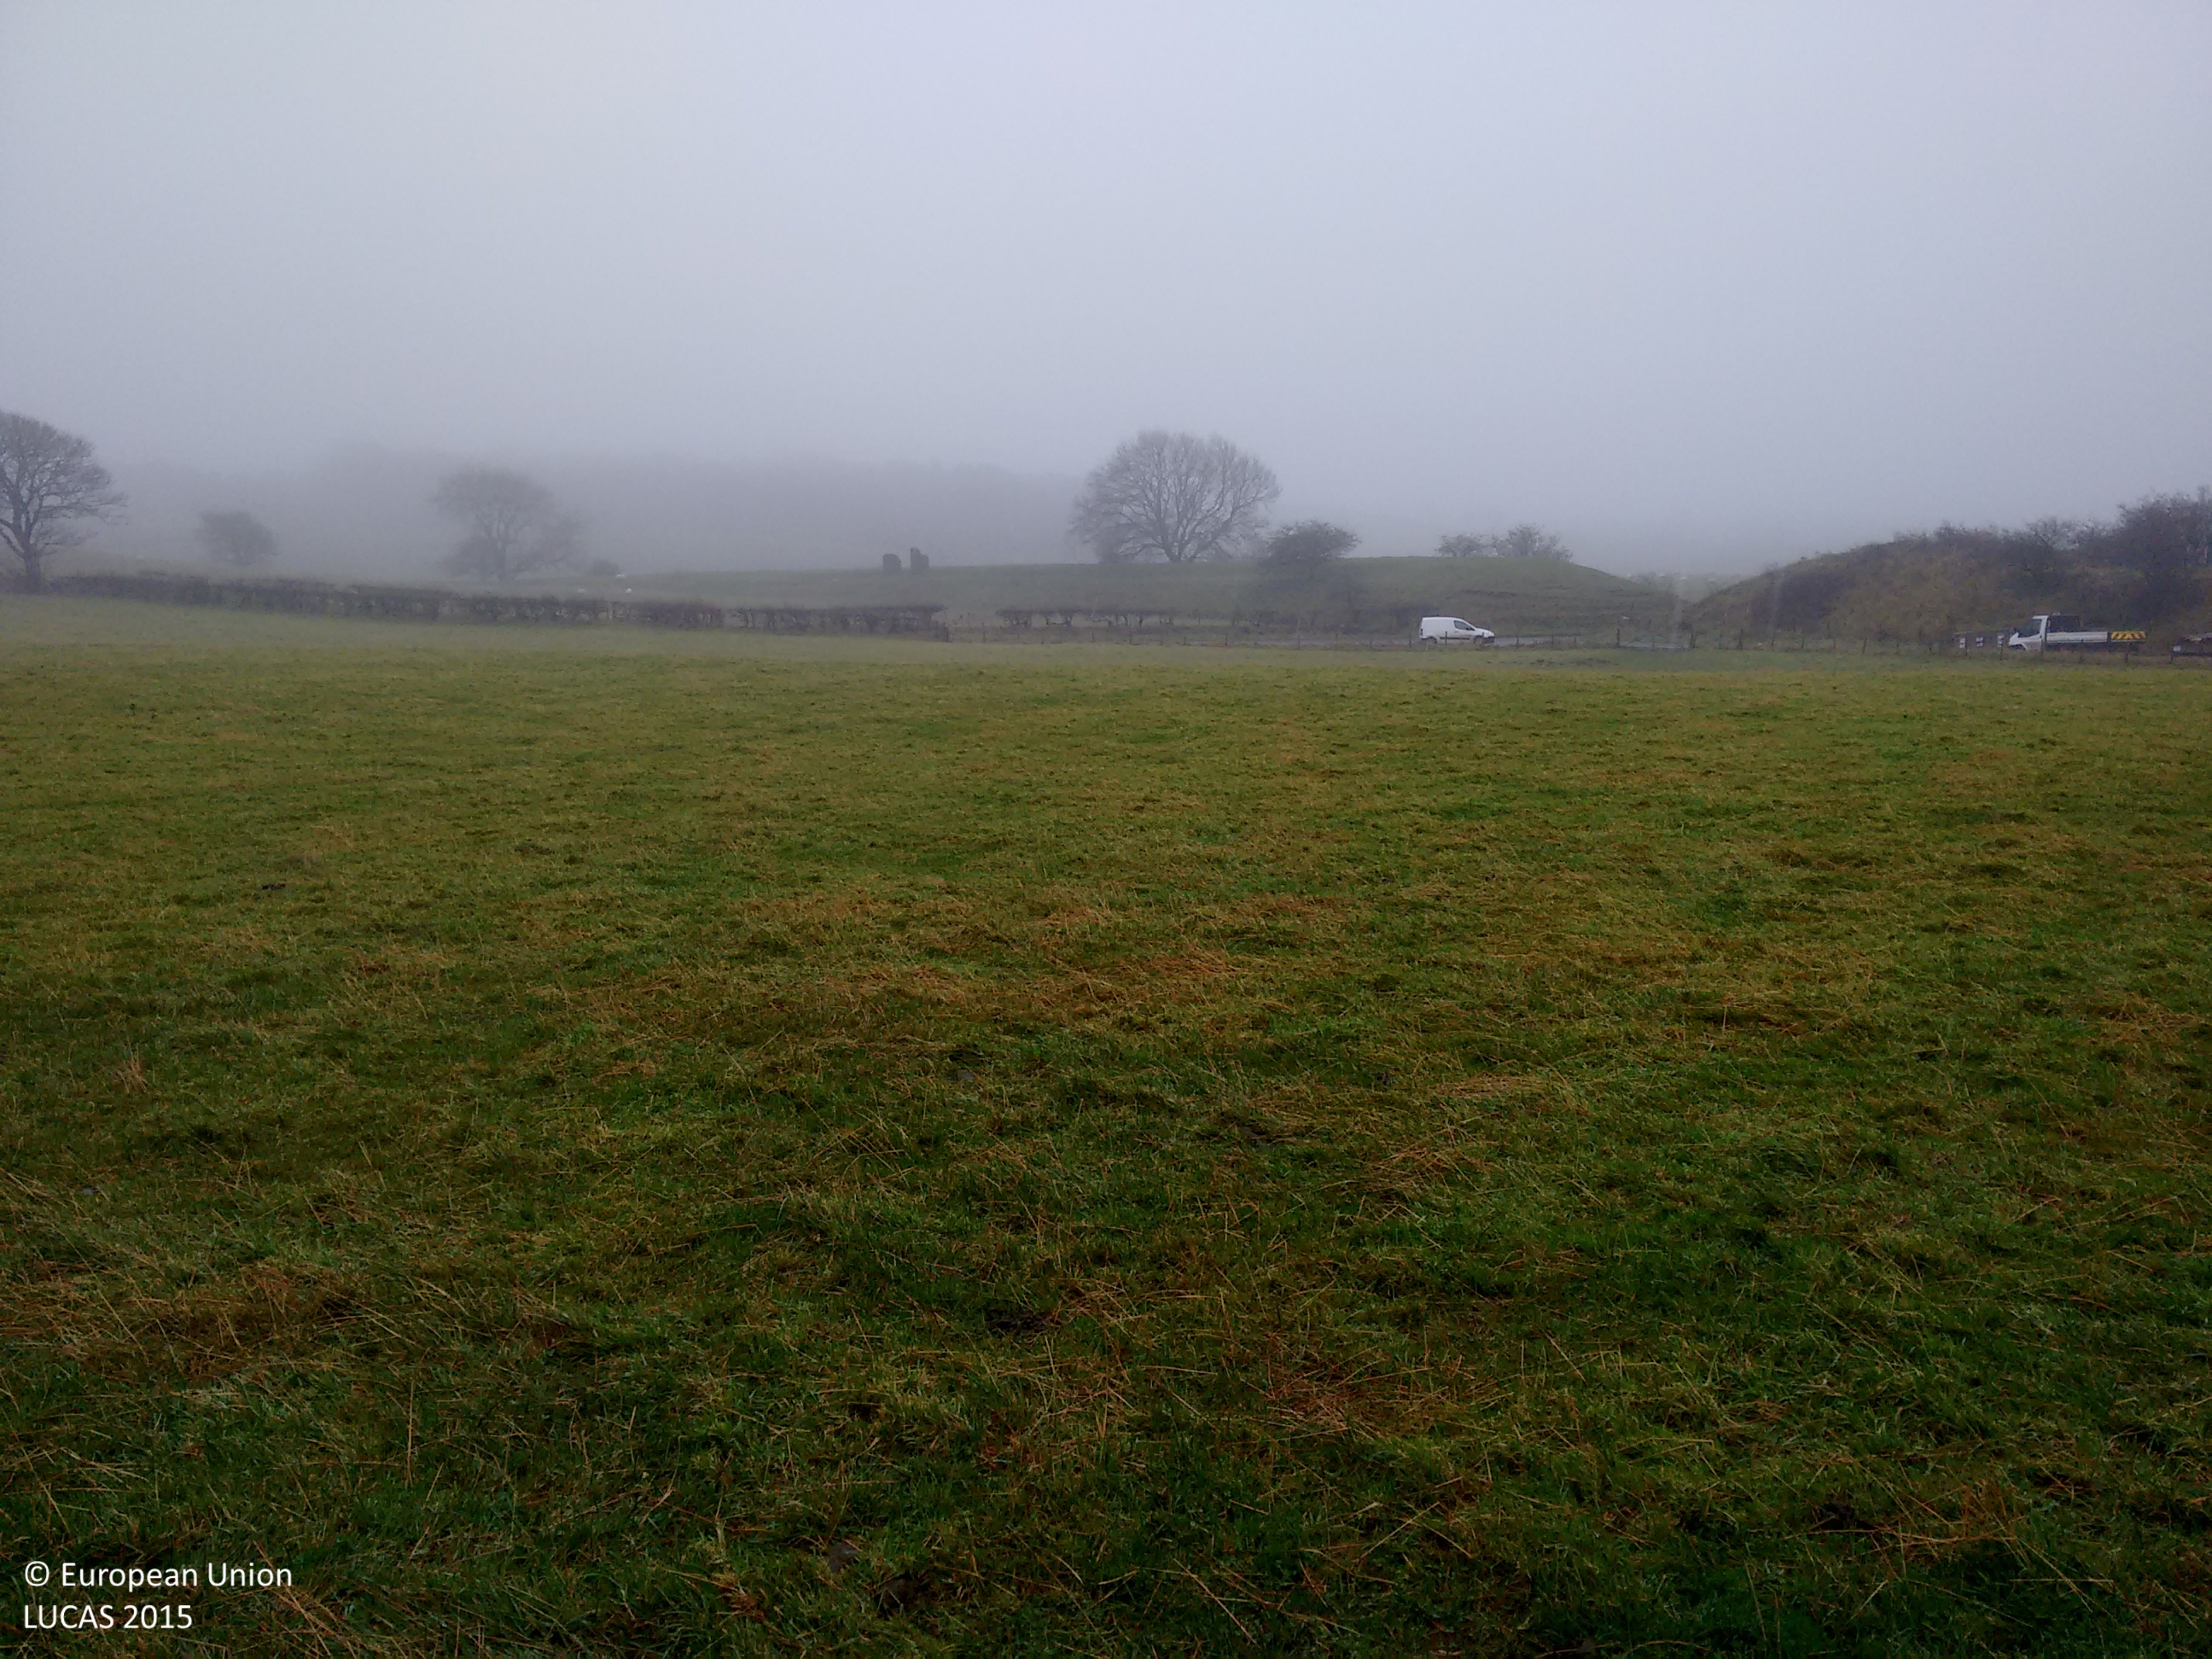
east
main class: Grassland
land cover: Grassland without tree/shrub cover
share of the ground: > 75 %
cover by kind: herbaceous plants 100 %
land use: Agriculture (excluding fallow land and kitchen gardens)
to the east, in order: Grassland without tree/shrub cover; Fences; Managed hedges; Grass margins; Paved roads, cycling and walking lanes; Grass margins; Fences; Managed hedges; Grassland without tree/shrub cover; Other structural elements; Grassland without tree/shrub cover; Rocks and stones; Grassland without tree/shrub cover
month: November
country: GB
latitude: 54.5442
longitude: -3.4521
